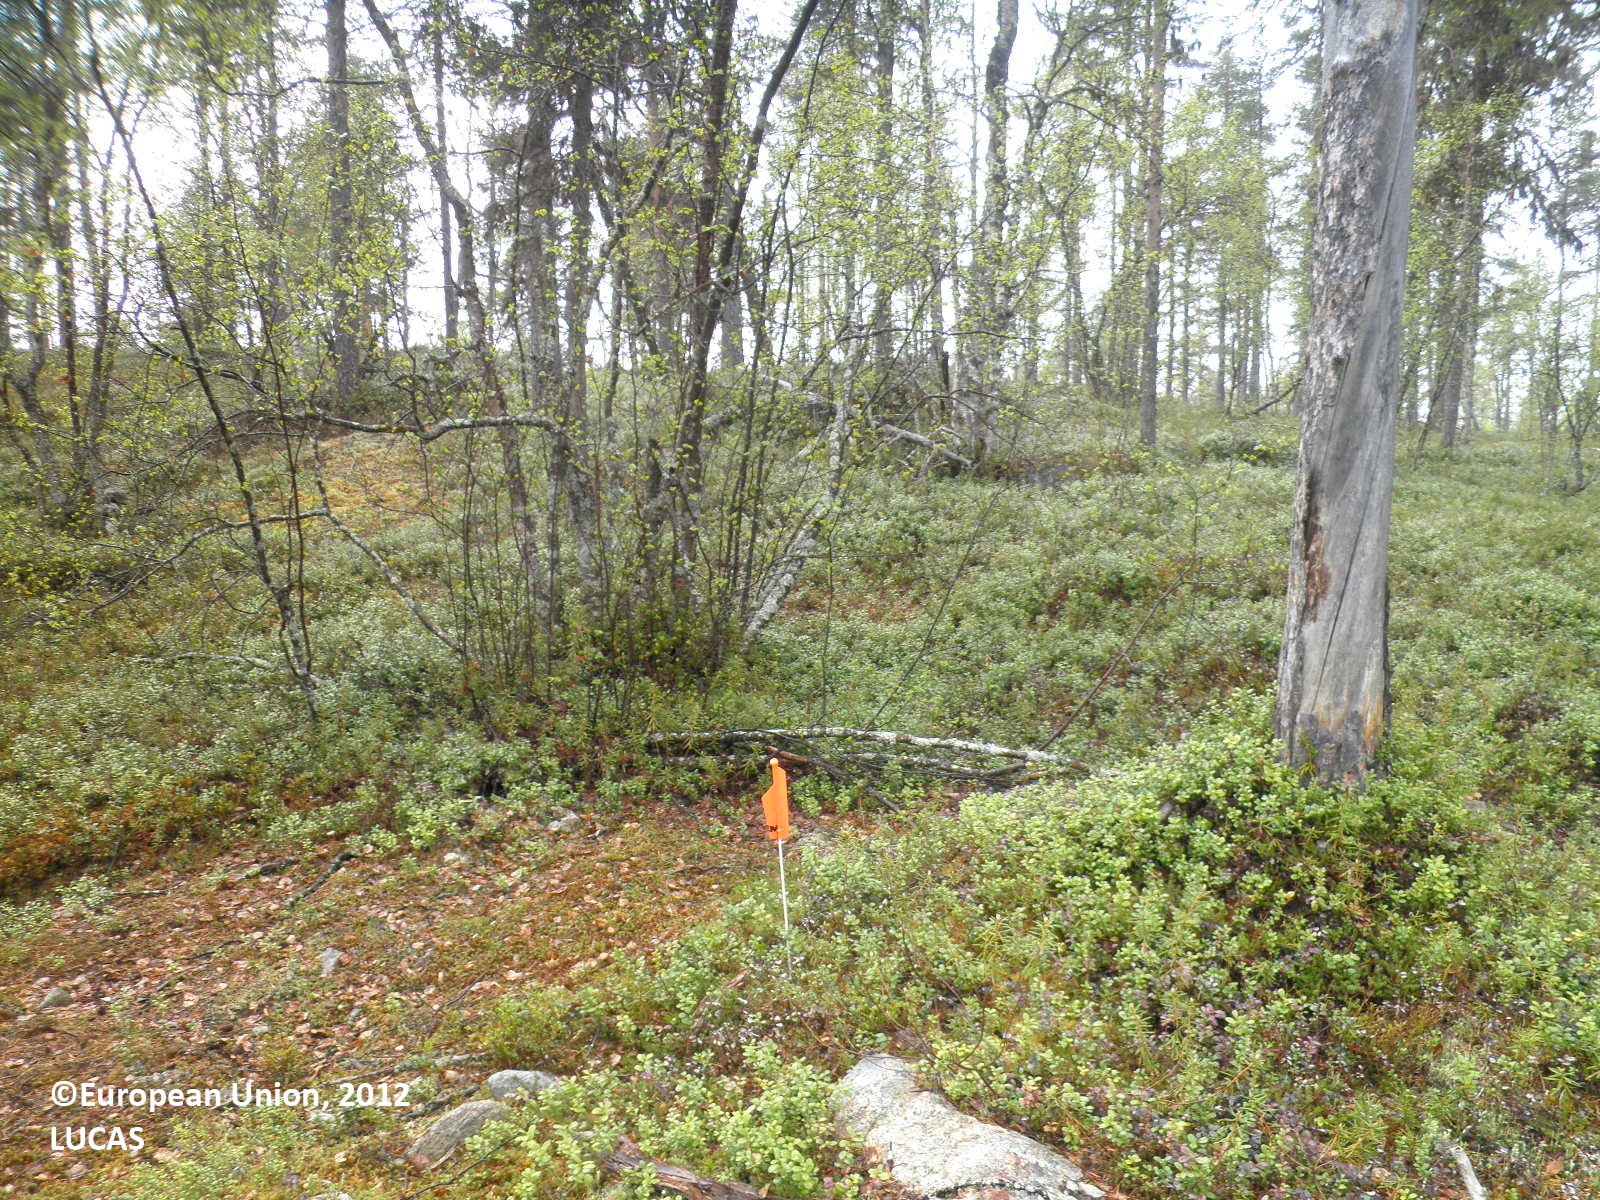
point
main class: Woodland
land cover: Pine dominated mixed woodland
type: boreal forest
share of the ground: 50 - 75 %
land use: Forestry
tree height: > 5 m
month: June
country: FI
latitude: 69.0504
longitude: 27.1265
